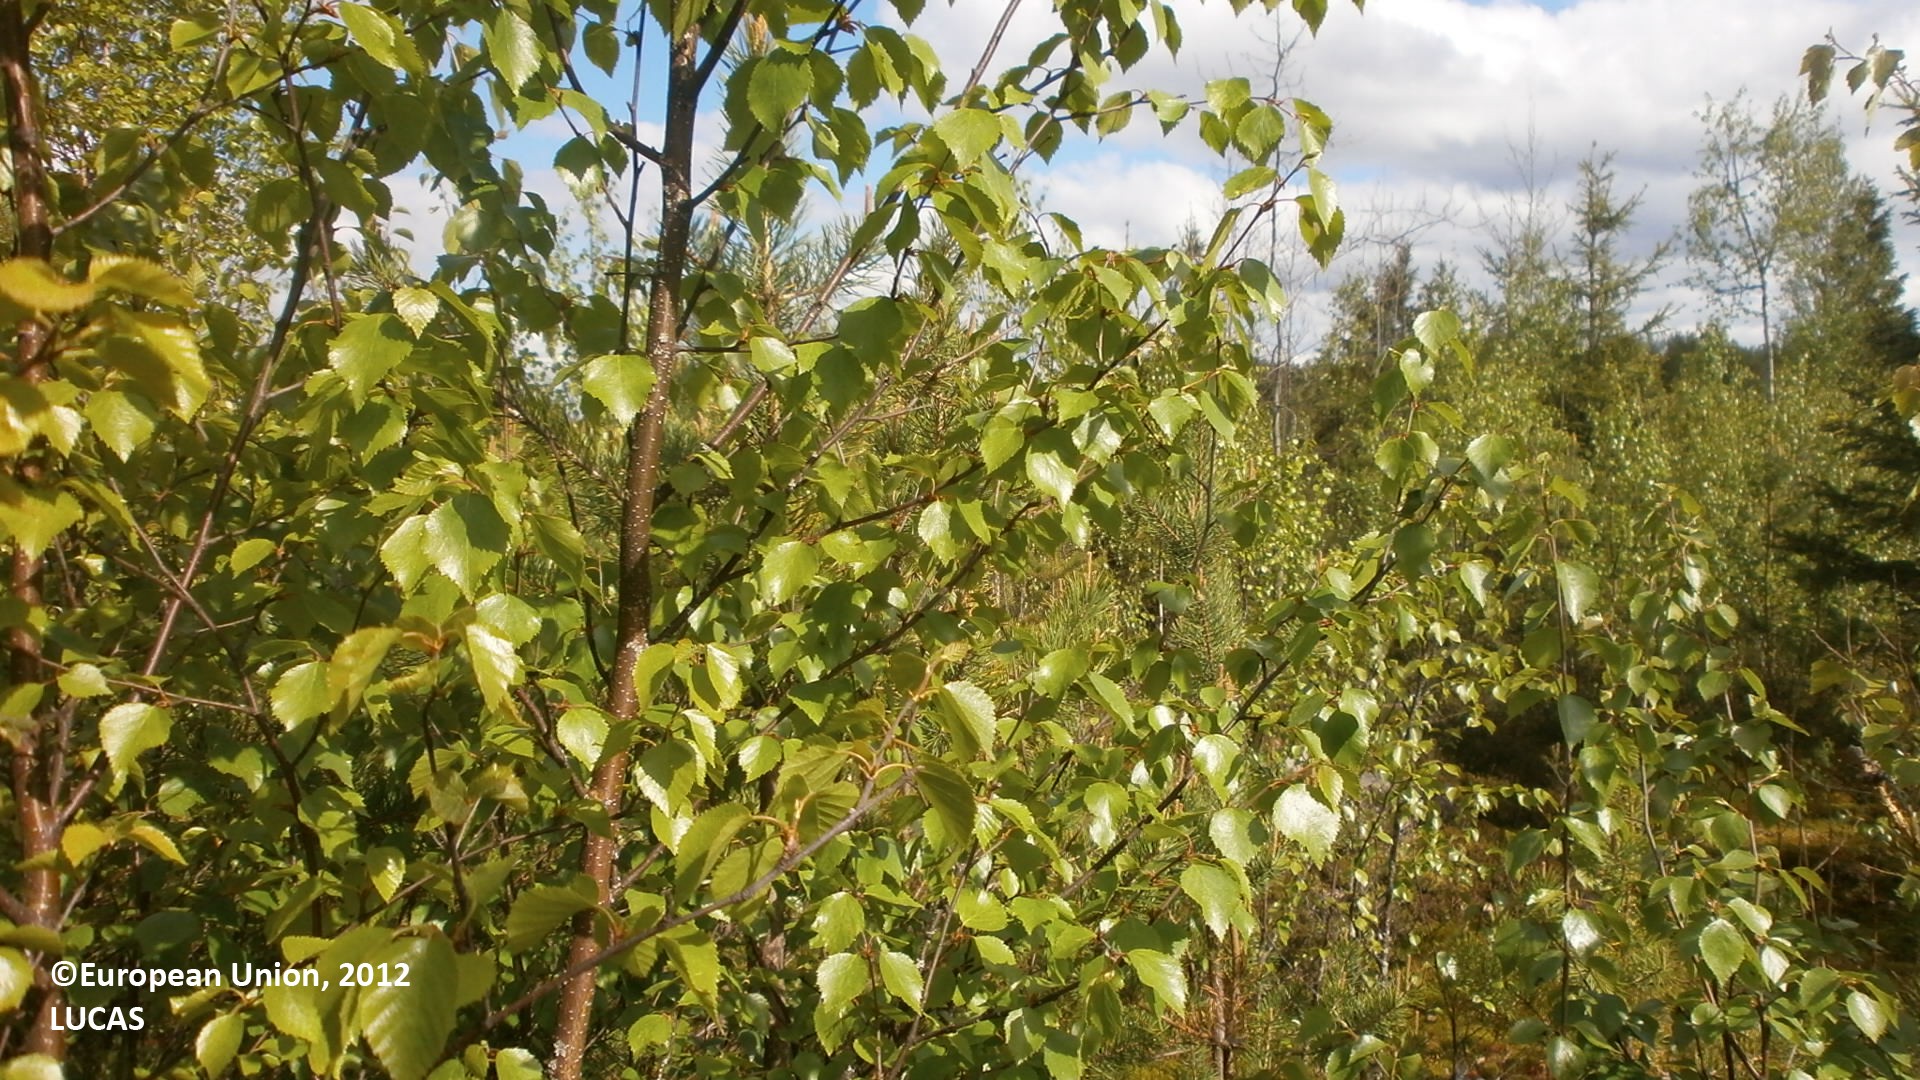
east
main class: Woodland
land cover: Other mixed woodland
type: mire and swamp forests
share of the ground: > 75 %
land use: Forestry
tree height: < 5 m
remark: Clear cut
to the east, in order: Other mixed woodland; Ditches and canals; Grass margins; Temporary grasslands; Other bare soil
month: June
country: FI
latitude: 64.5112
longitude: 25.1824
